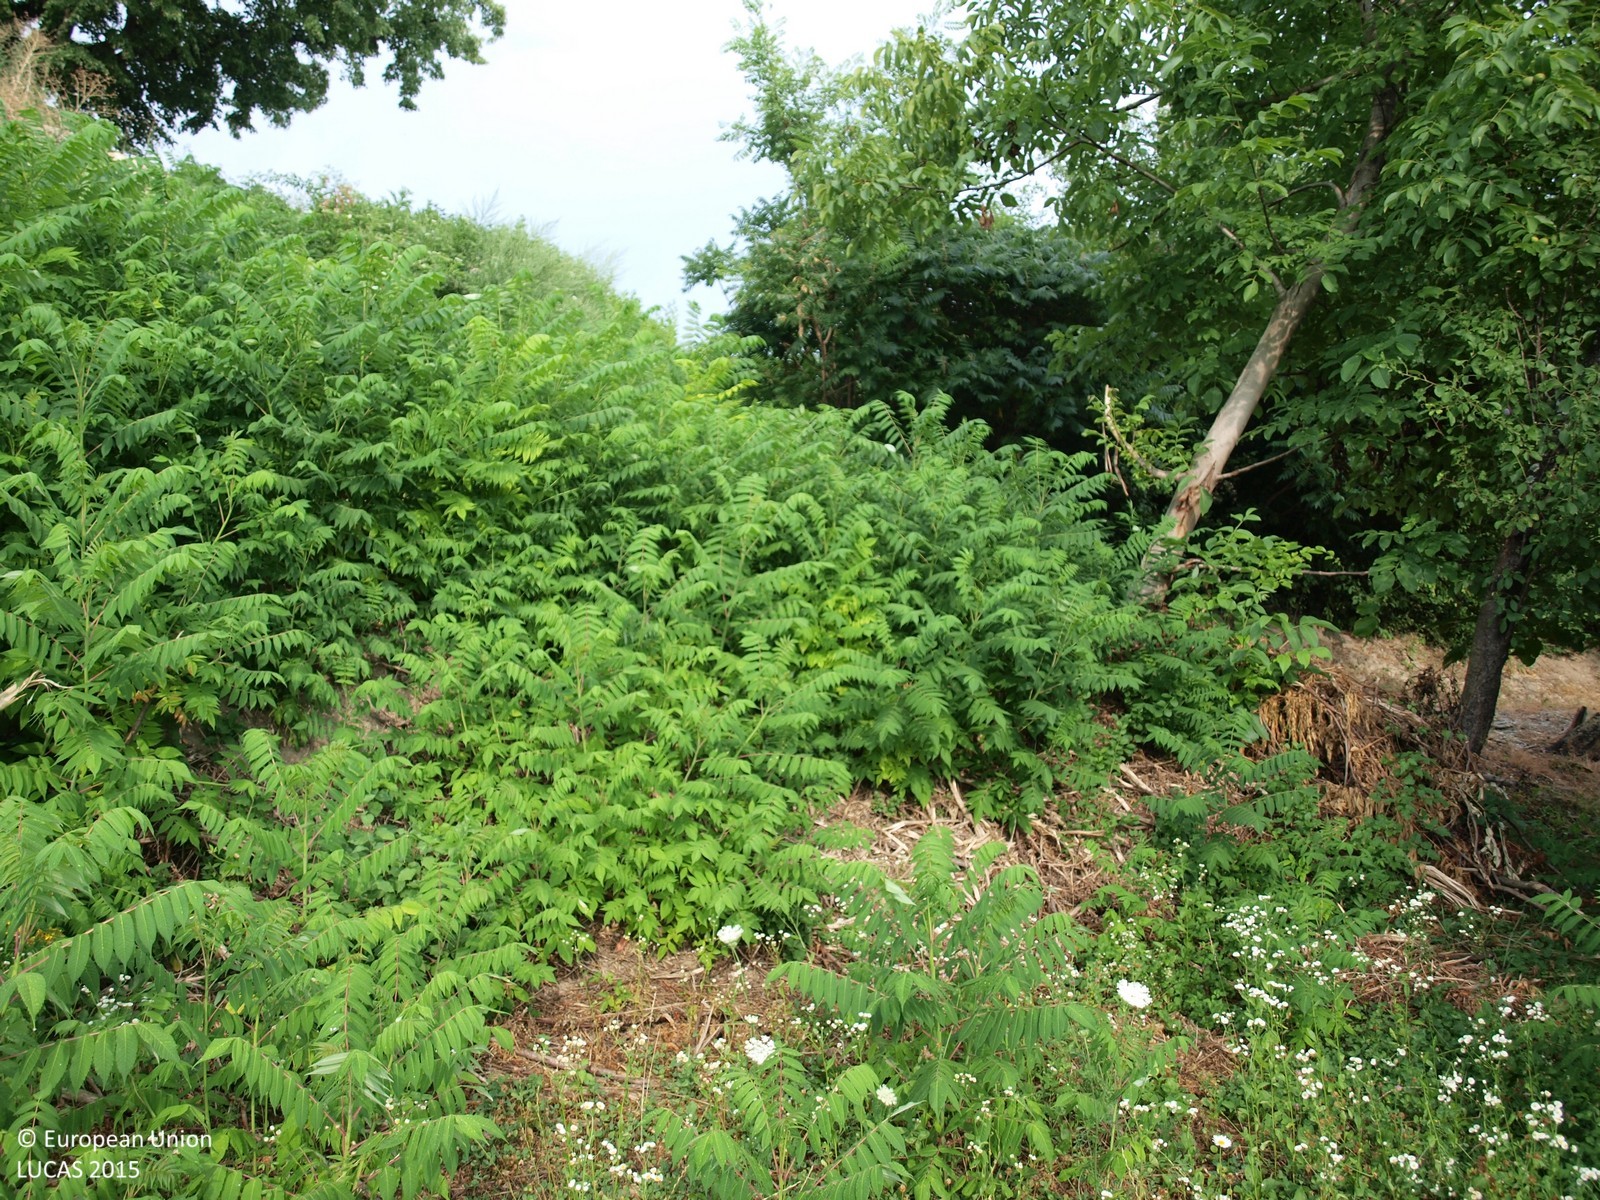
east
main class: Grassland
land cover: Grassland with sparse tree/shrub cover
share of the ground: > 75 %
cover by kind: herbaceous plants 95 %, broadleaved forest trees 5 %
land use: Agriculture (excluding fallow land and kitchen gardens)
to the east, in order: Grassland with sparse tree/shrub cover; Tracks; Shrubland without tree cover; Grassland with sparse tree/shrub cover; Shrubland without tree cover; Electric lines; Tracks; Grassland without tree/shrub cover; Apple fruit; Maize; Dry pulses; Rivers and streams; Potatoes; Paved roads, cycling and walking lanes; Electric lines; Grassland without tree/shrub cover; Apple fruit
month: July
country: HR
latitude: 45.9378
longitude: 16.1768
